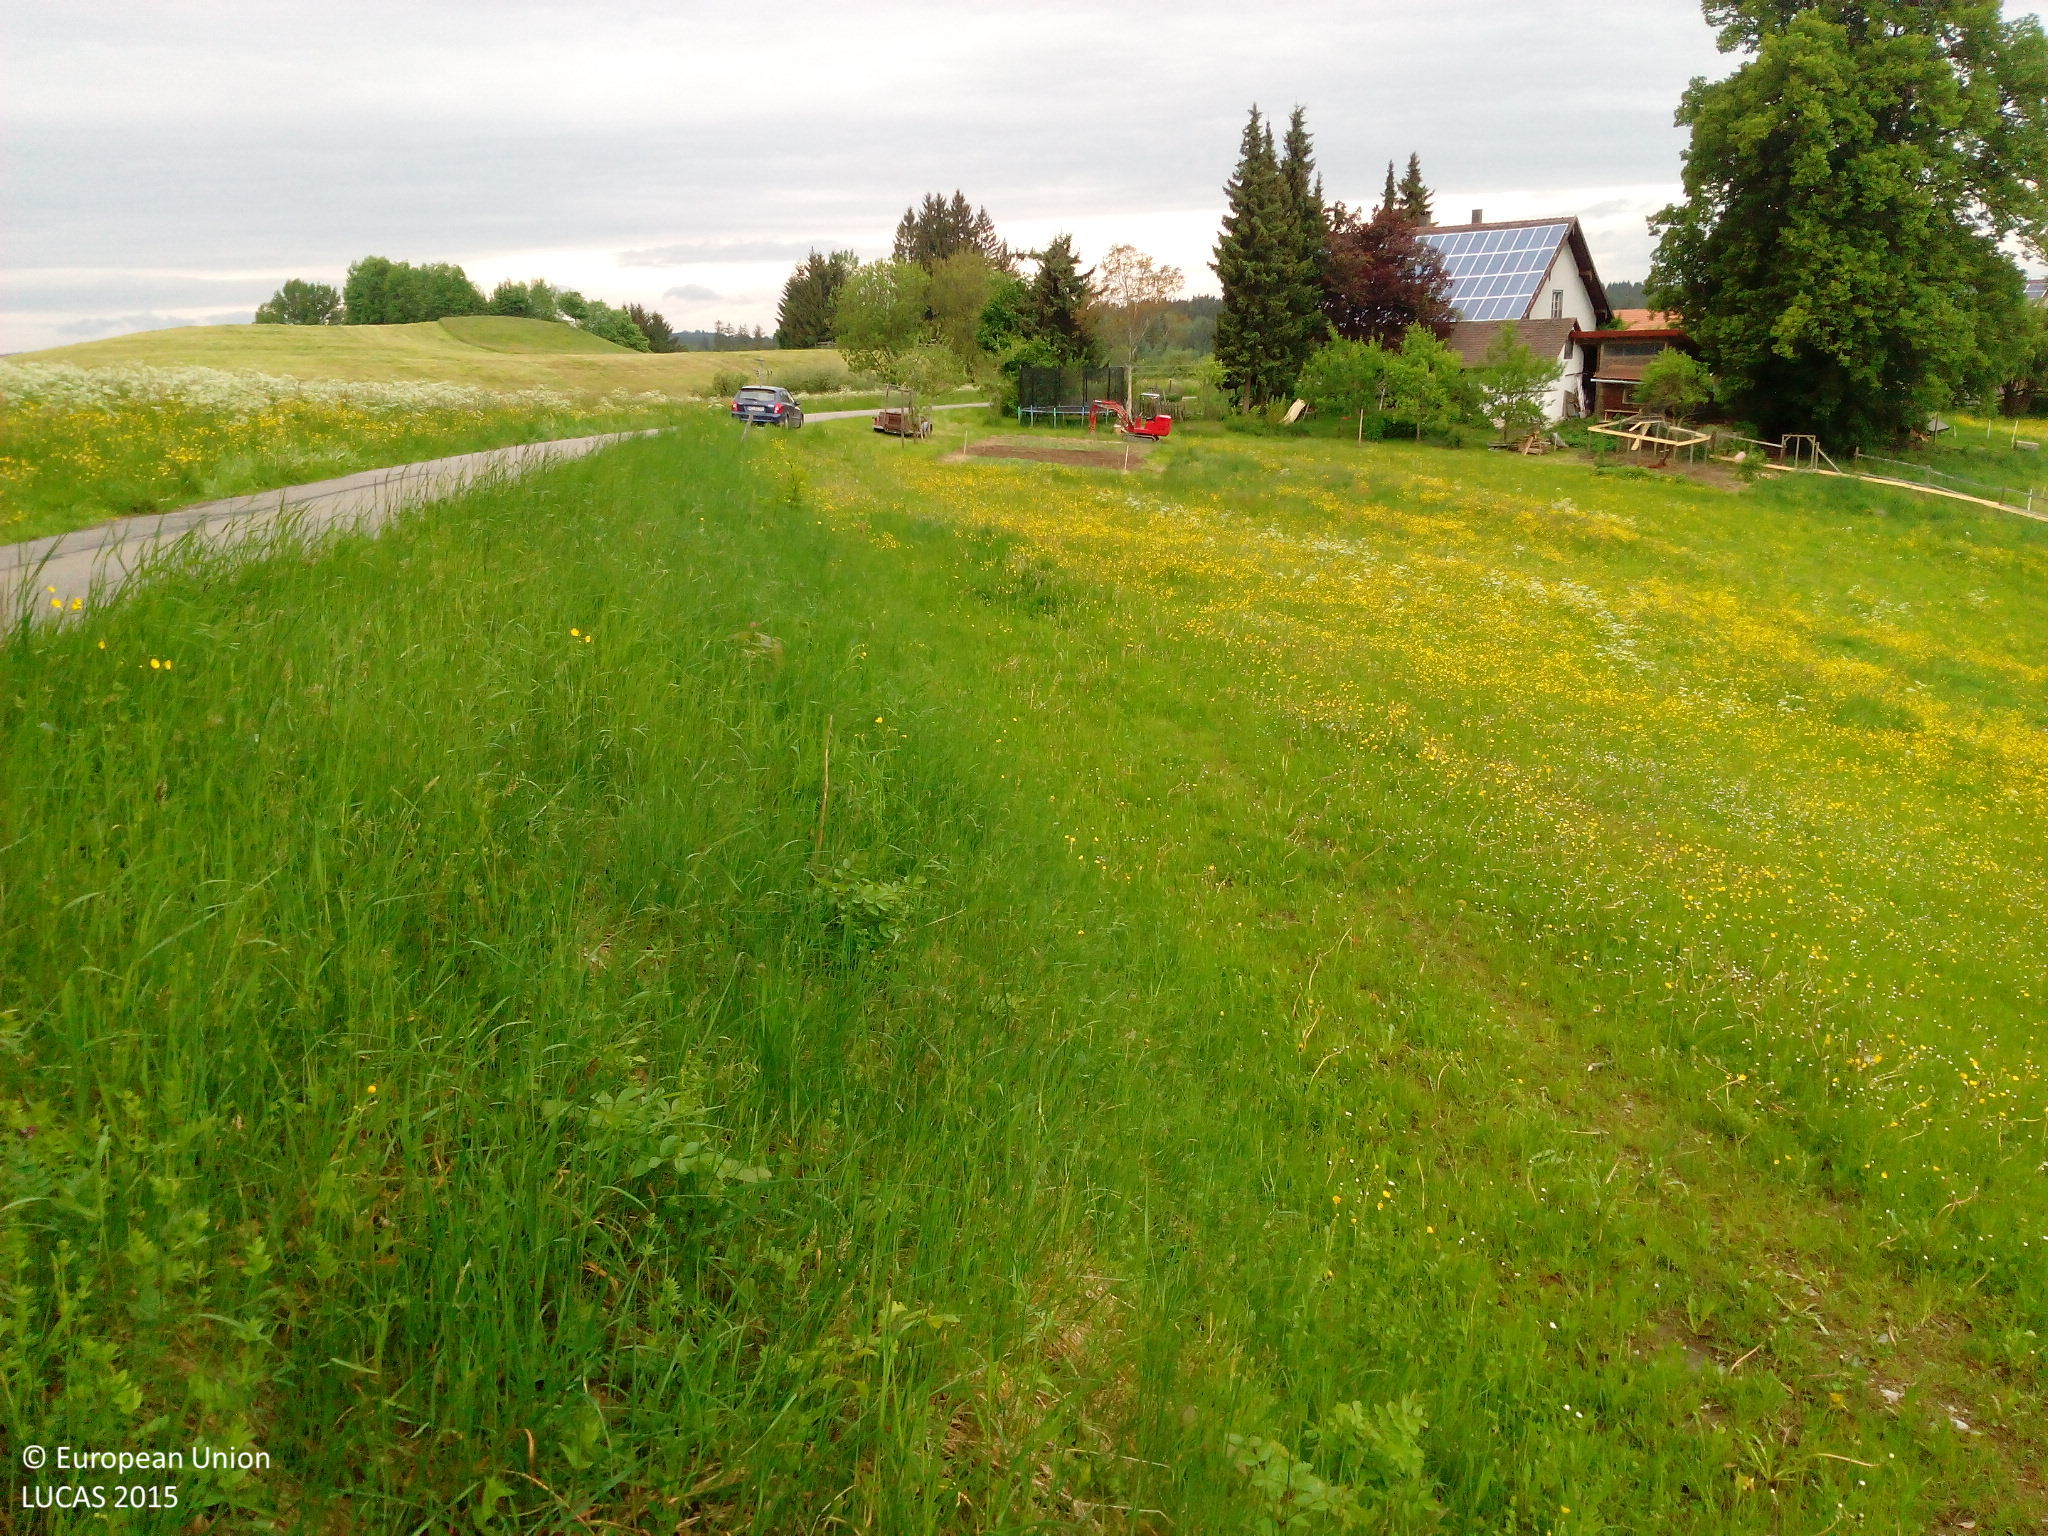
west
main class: Grassland
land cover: Grassland without tree/shrub cover
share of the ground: > 75 %
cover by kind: herbaceous plants 100 %
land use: Agriculture (excluding fallow land and kitchen gardens)
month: May
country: DE
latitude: 47.8275
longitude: 9.8532
